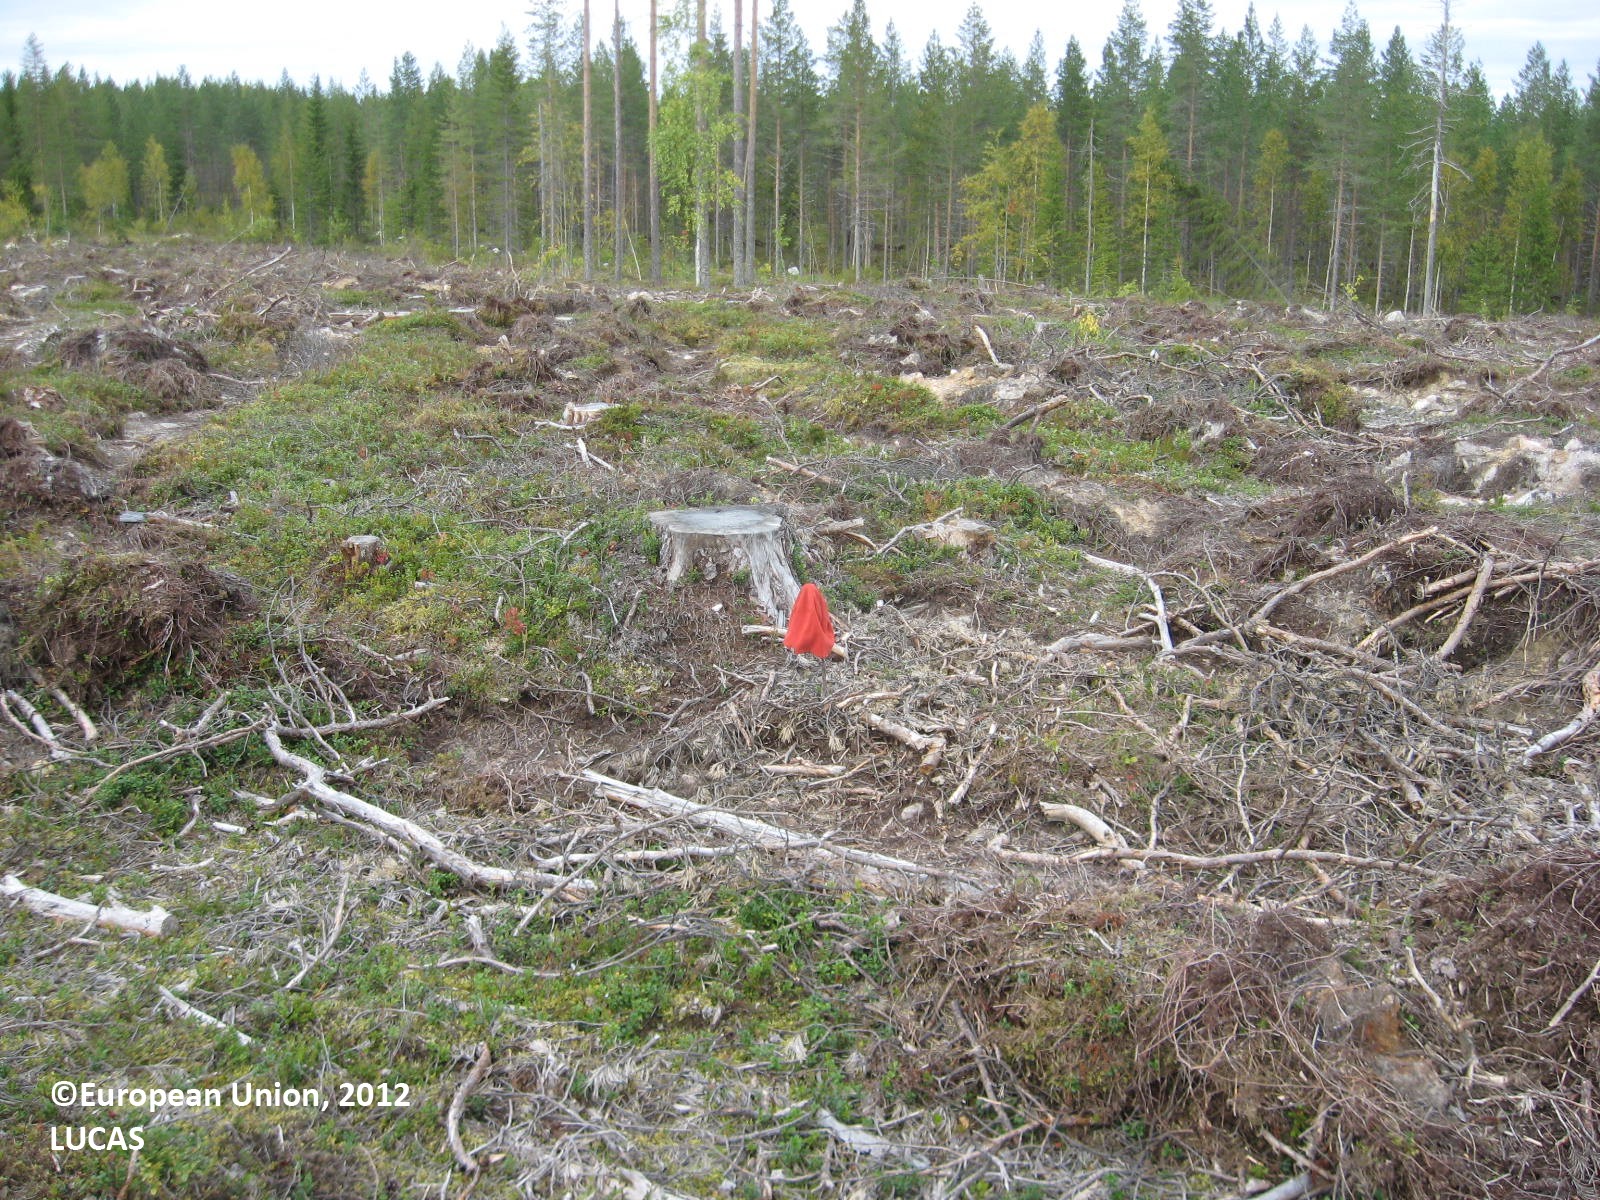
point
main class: Grassland
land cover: Grassland without tree/shrub cover
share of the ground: > 75 %
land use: Forestry
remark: Clear cut
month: August
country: FI
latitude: 63.9707
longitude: 29.2252
